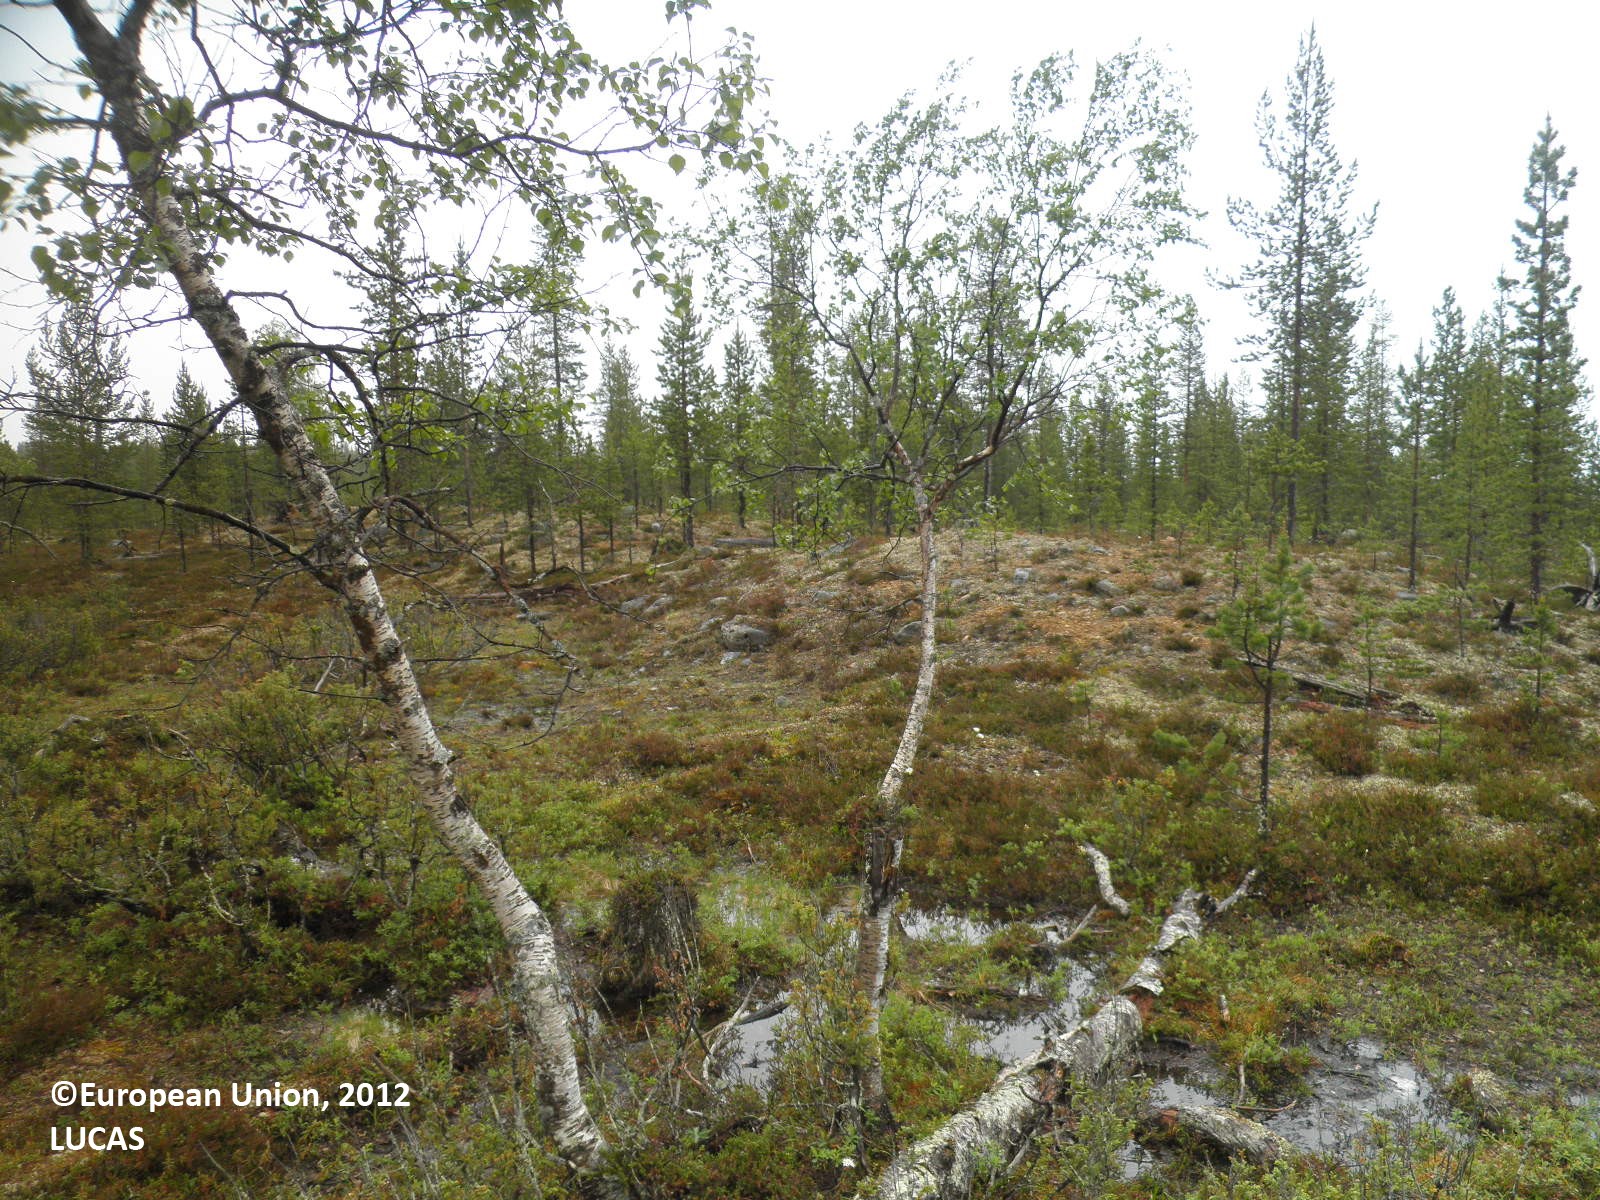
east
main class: Woodland
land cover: Pine dominated coniferous woodland
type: boreal forest
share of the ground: 25 - 50 %
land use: Forestry
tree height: > 5 m
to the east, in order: Pine dominated coniferous woodland; Ponds and wetlands; Pine dominated coniferous woodland; Pine dominated mixed woodland; Pine dominated coniferous woodland; Tracks; Pine dominated coniferous woodland
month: June
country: FI
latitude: 68.4796
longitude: 27.7986
